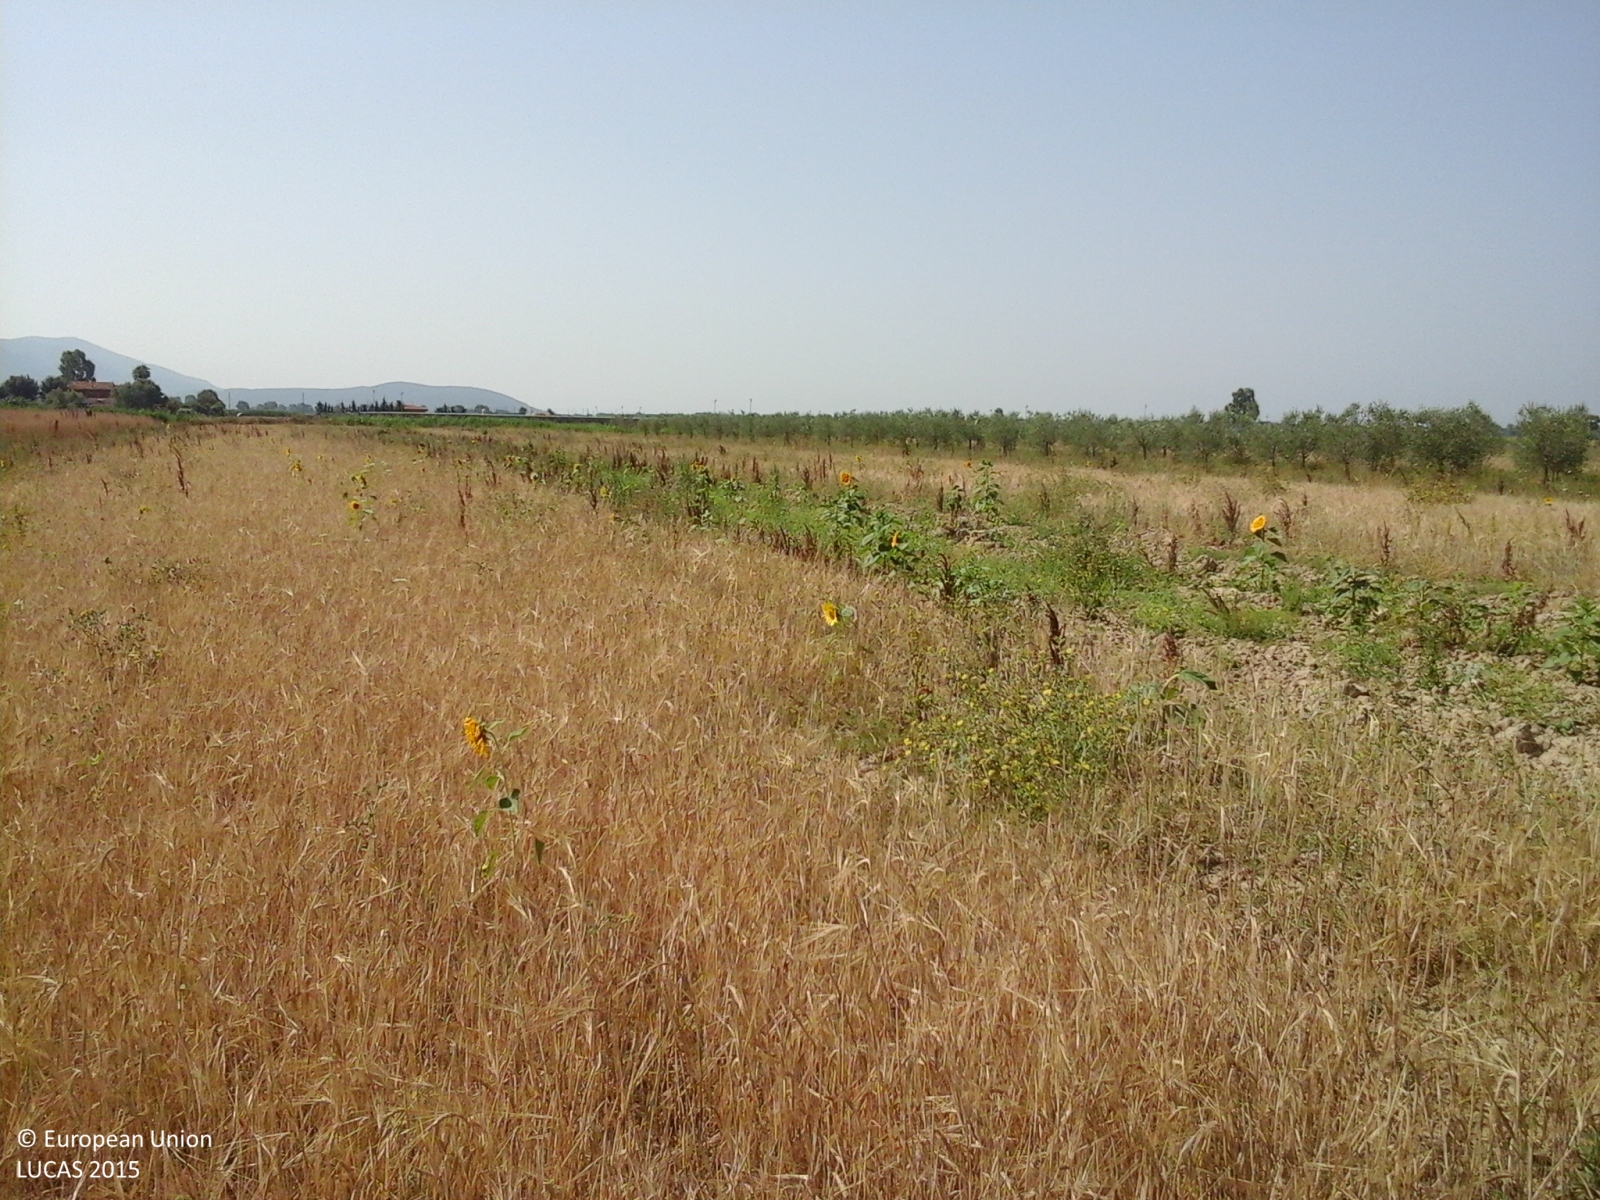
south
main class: Cropland
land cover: Barley
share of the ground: > 75 %
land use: Agriculture (excluding fallow land and kitchen gardens)
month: July
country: IT
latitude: 42.7210
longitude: 11.0346
